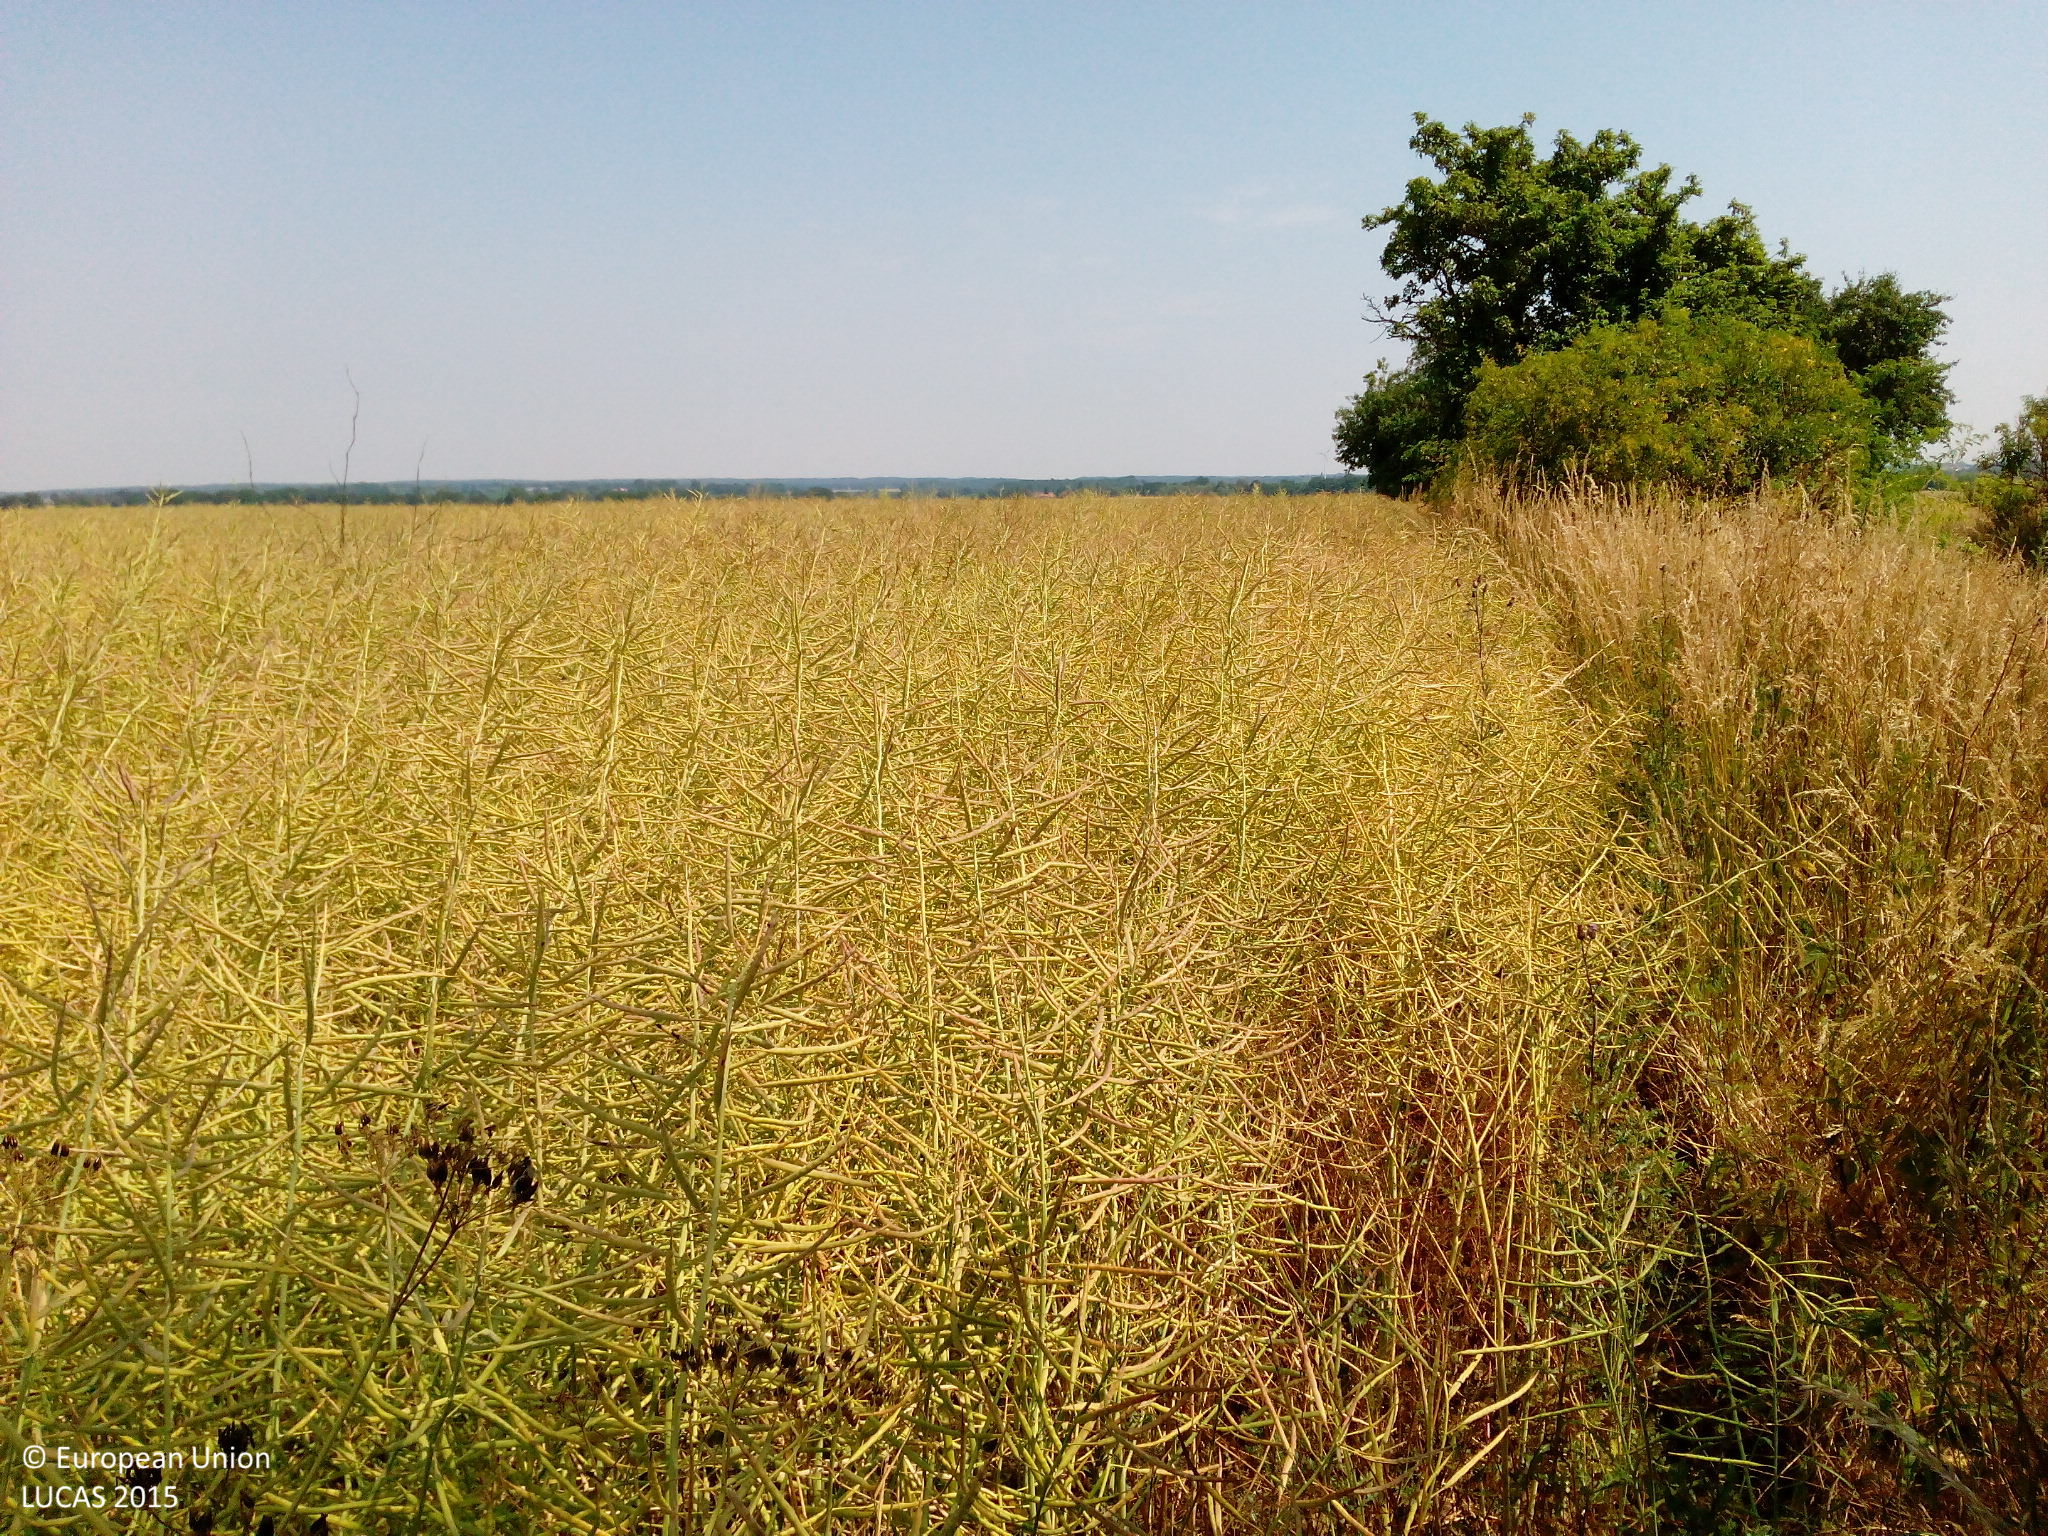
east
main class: Cropland
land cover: Rape and turnip rape
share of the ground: > 75 %
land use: Agriculture (excluding fallow land and kitchen gardens)
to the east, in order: Rape and turnip rape; Abandoned hedges; Tracks; Abandoned hedges; Rape and turnip rape
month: July
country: DE
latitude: 52.4495
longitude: 14.1356
